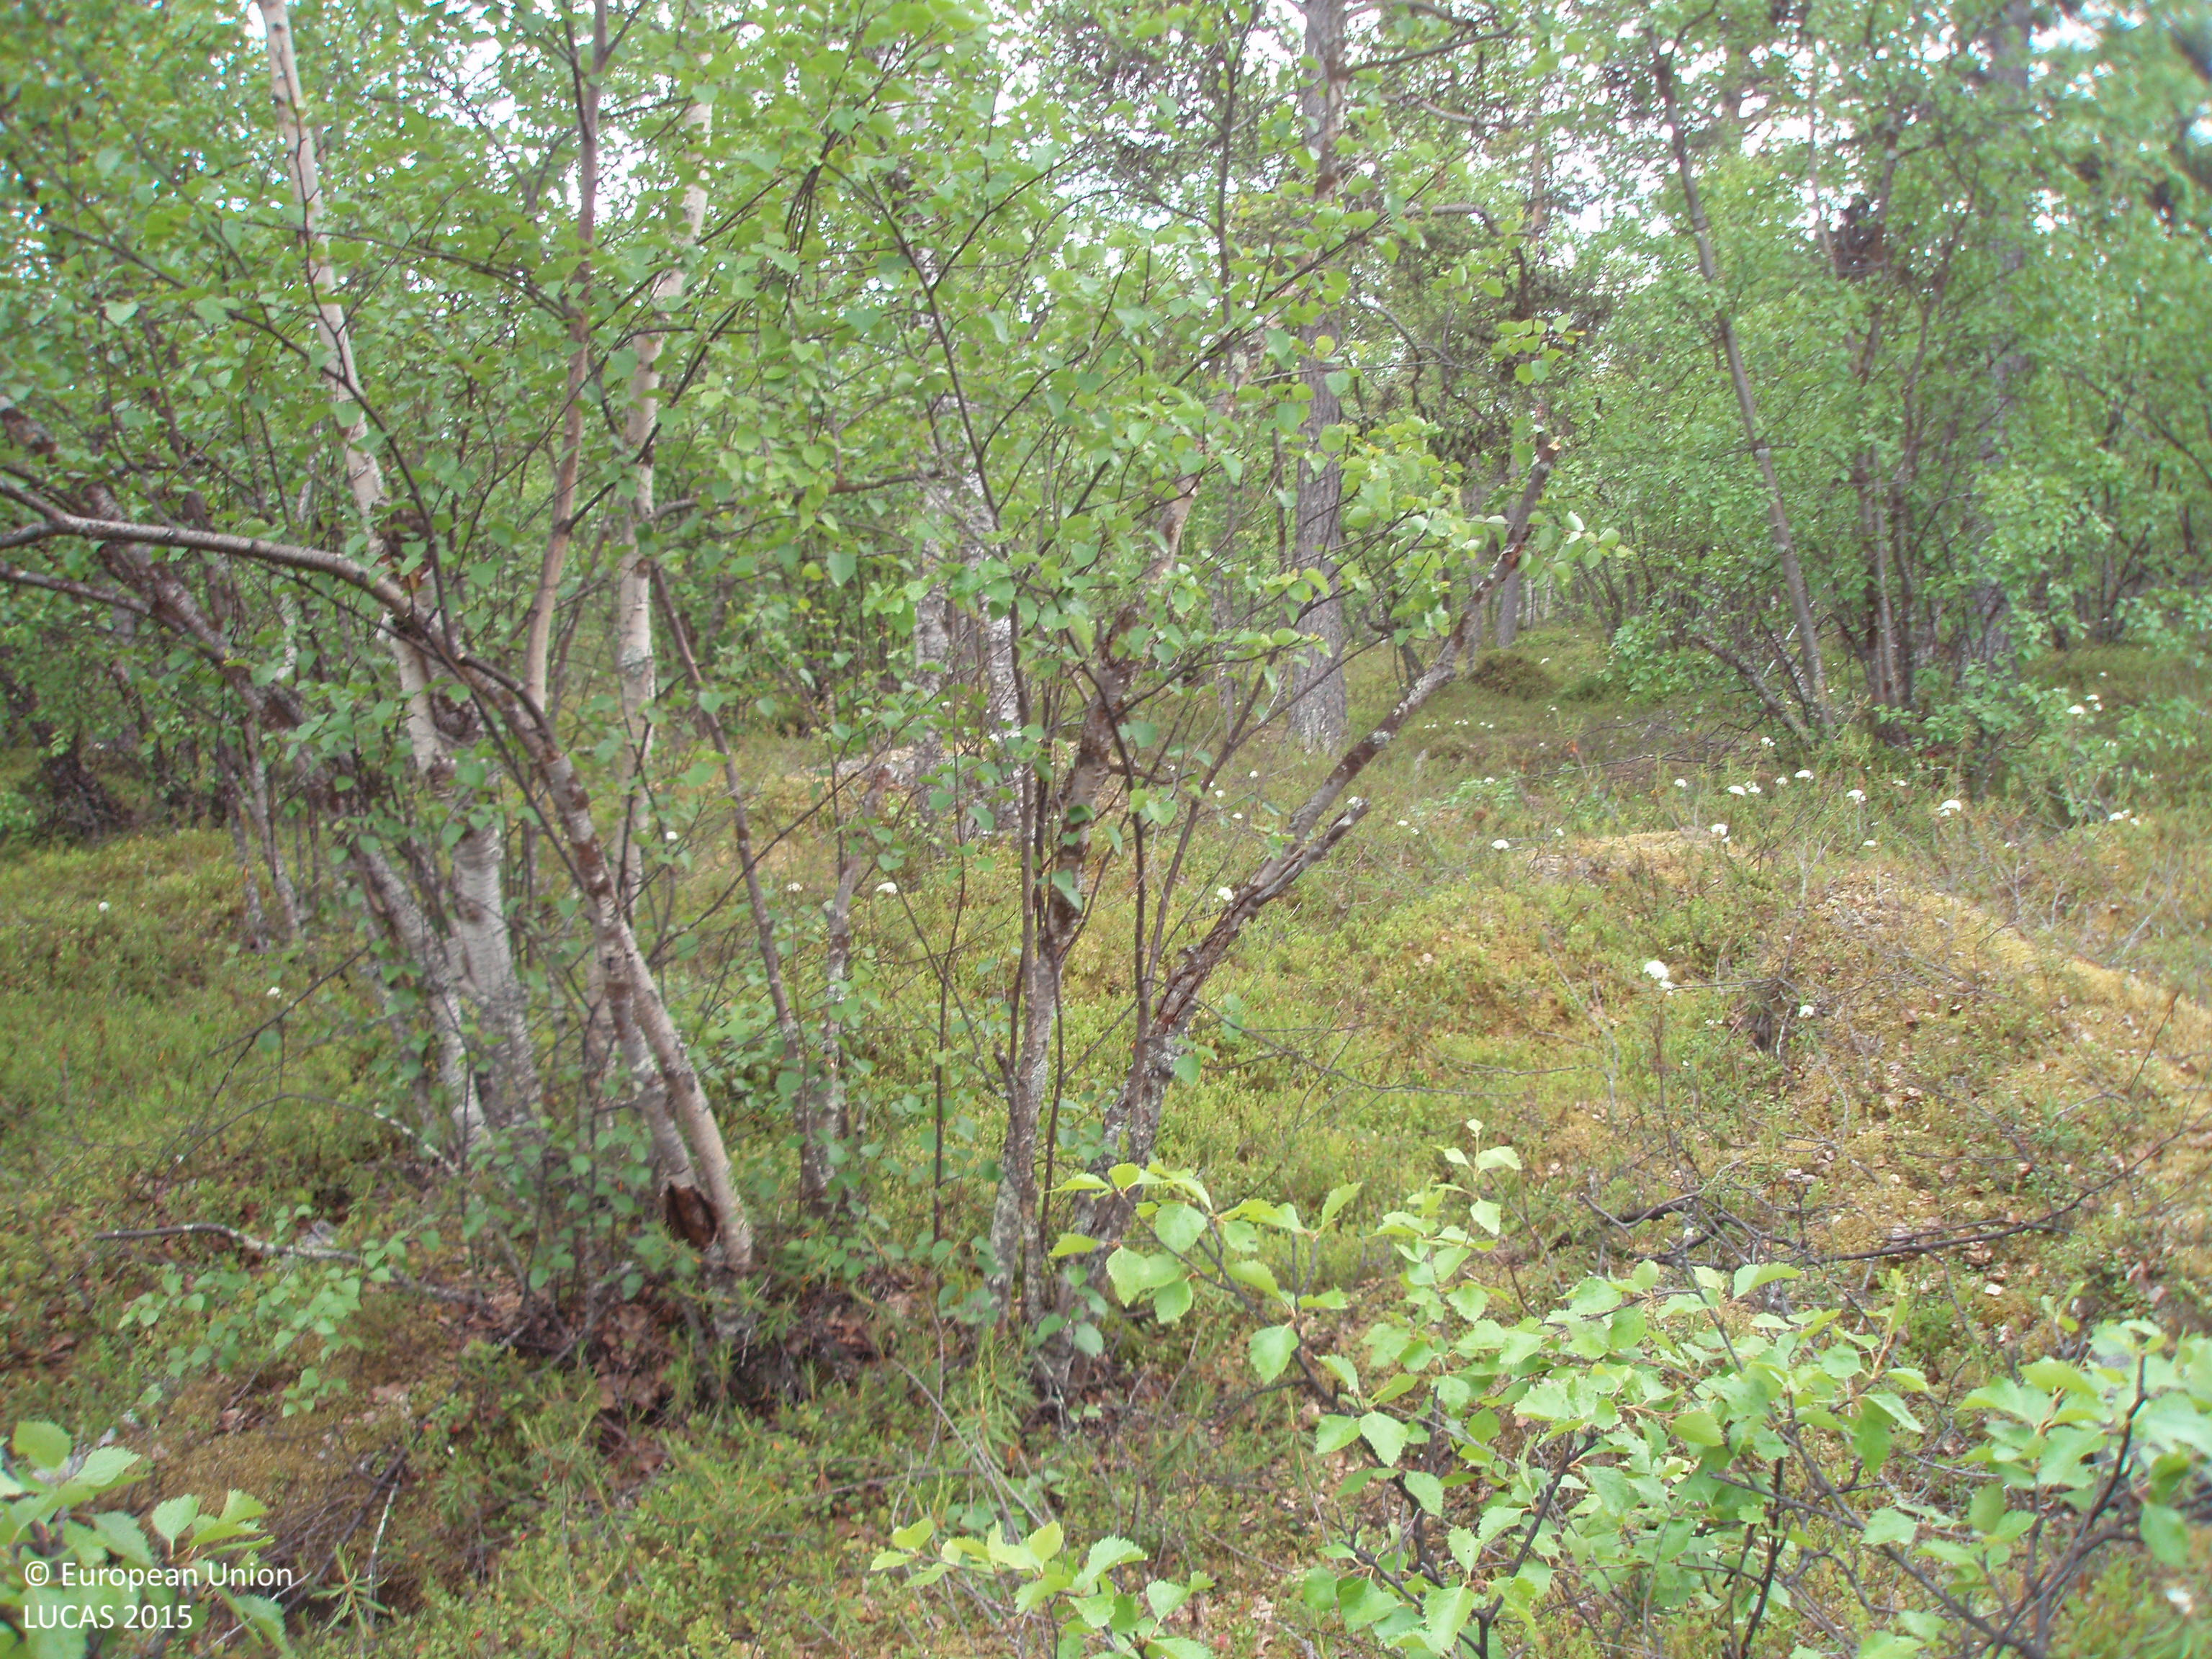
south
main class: Woodland
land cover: Pine dominated mixed woodland
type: boreal forest
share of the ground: > 75 %
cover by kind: broadleaved forest trees 50 %, coniferous forest trees 25 %, shrubs 25 %
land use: Forestry
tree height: > 5 m
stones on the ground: 10 - 25 %
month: July
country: FI
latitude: 69.1573
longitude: 27.7796
